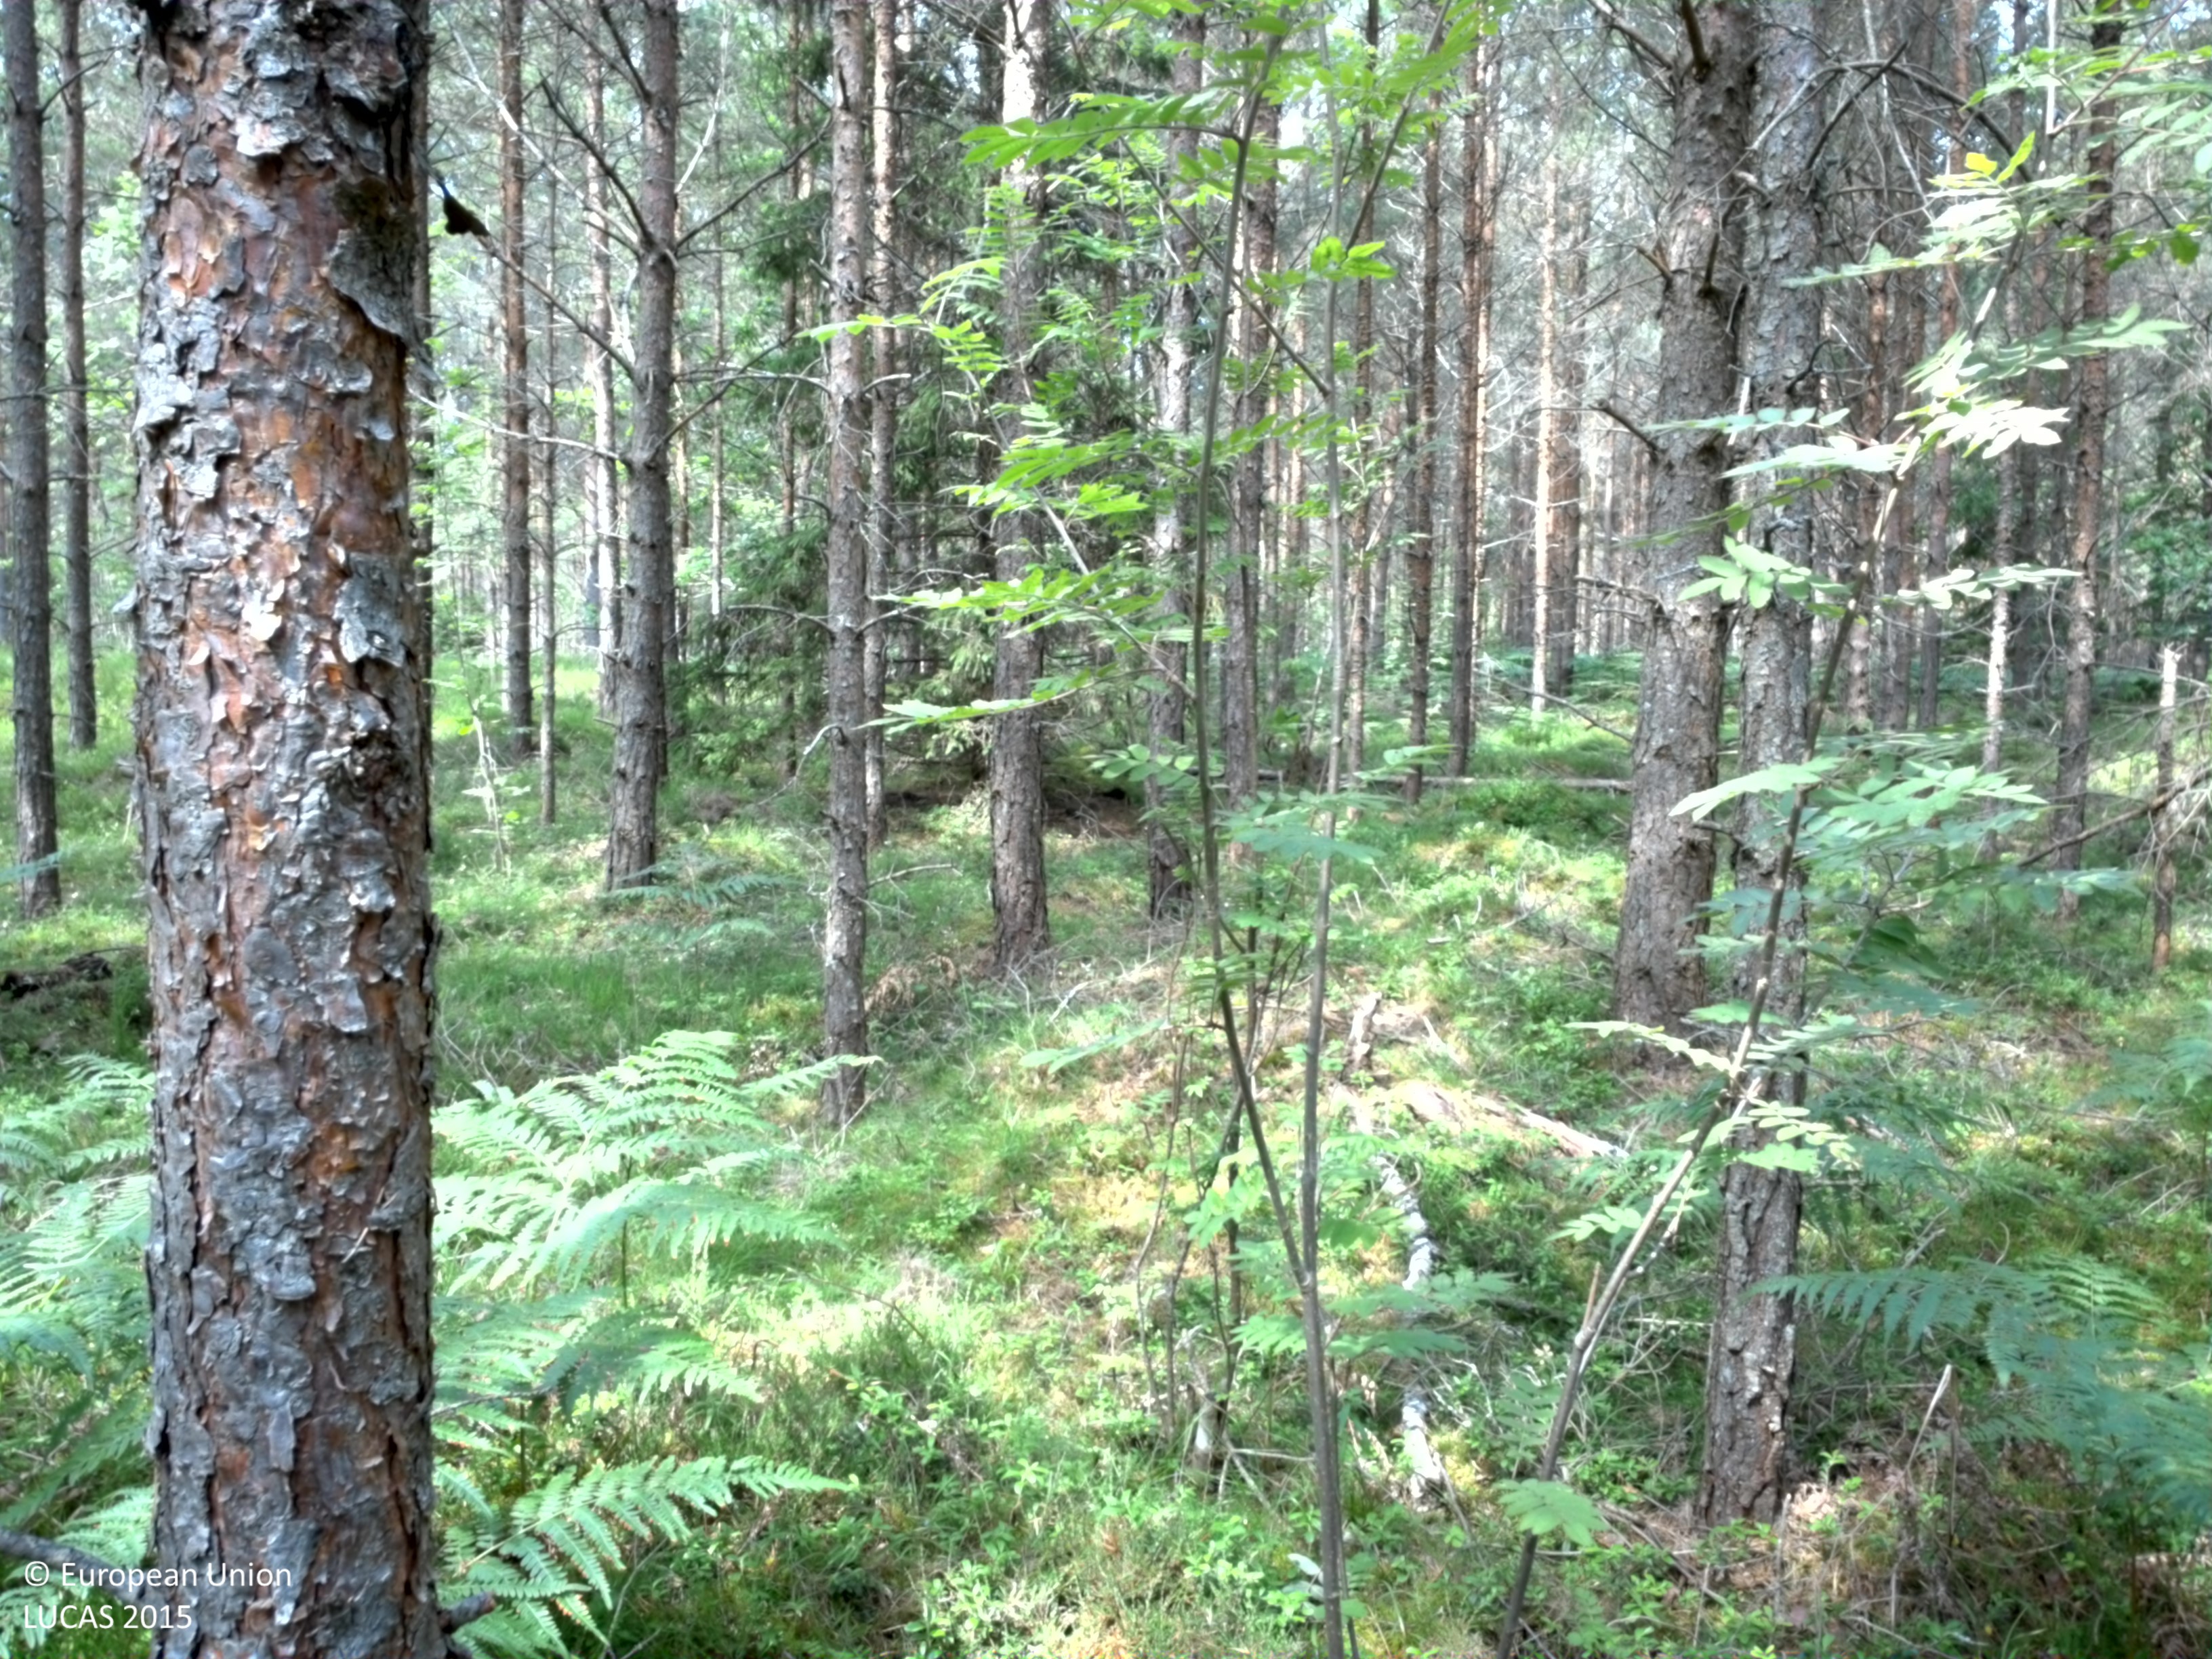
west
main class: Woodland
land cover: Pine dominated coniferous woodland
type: hemiboreal forest and nemoral coniferous forest and mixed broadleaved-coniferous forest
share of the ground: > 75 %
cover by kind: coniferous forest trees 80 %, herbaceous plants 15 %, broadleaved forest trees 5 %
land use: Forestry
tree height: > 5 m
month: July
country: SE
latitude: 57.3554
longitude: 18.7371
